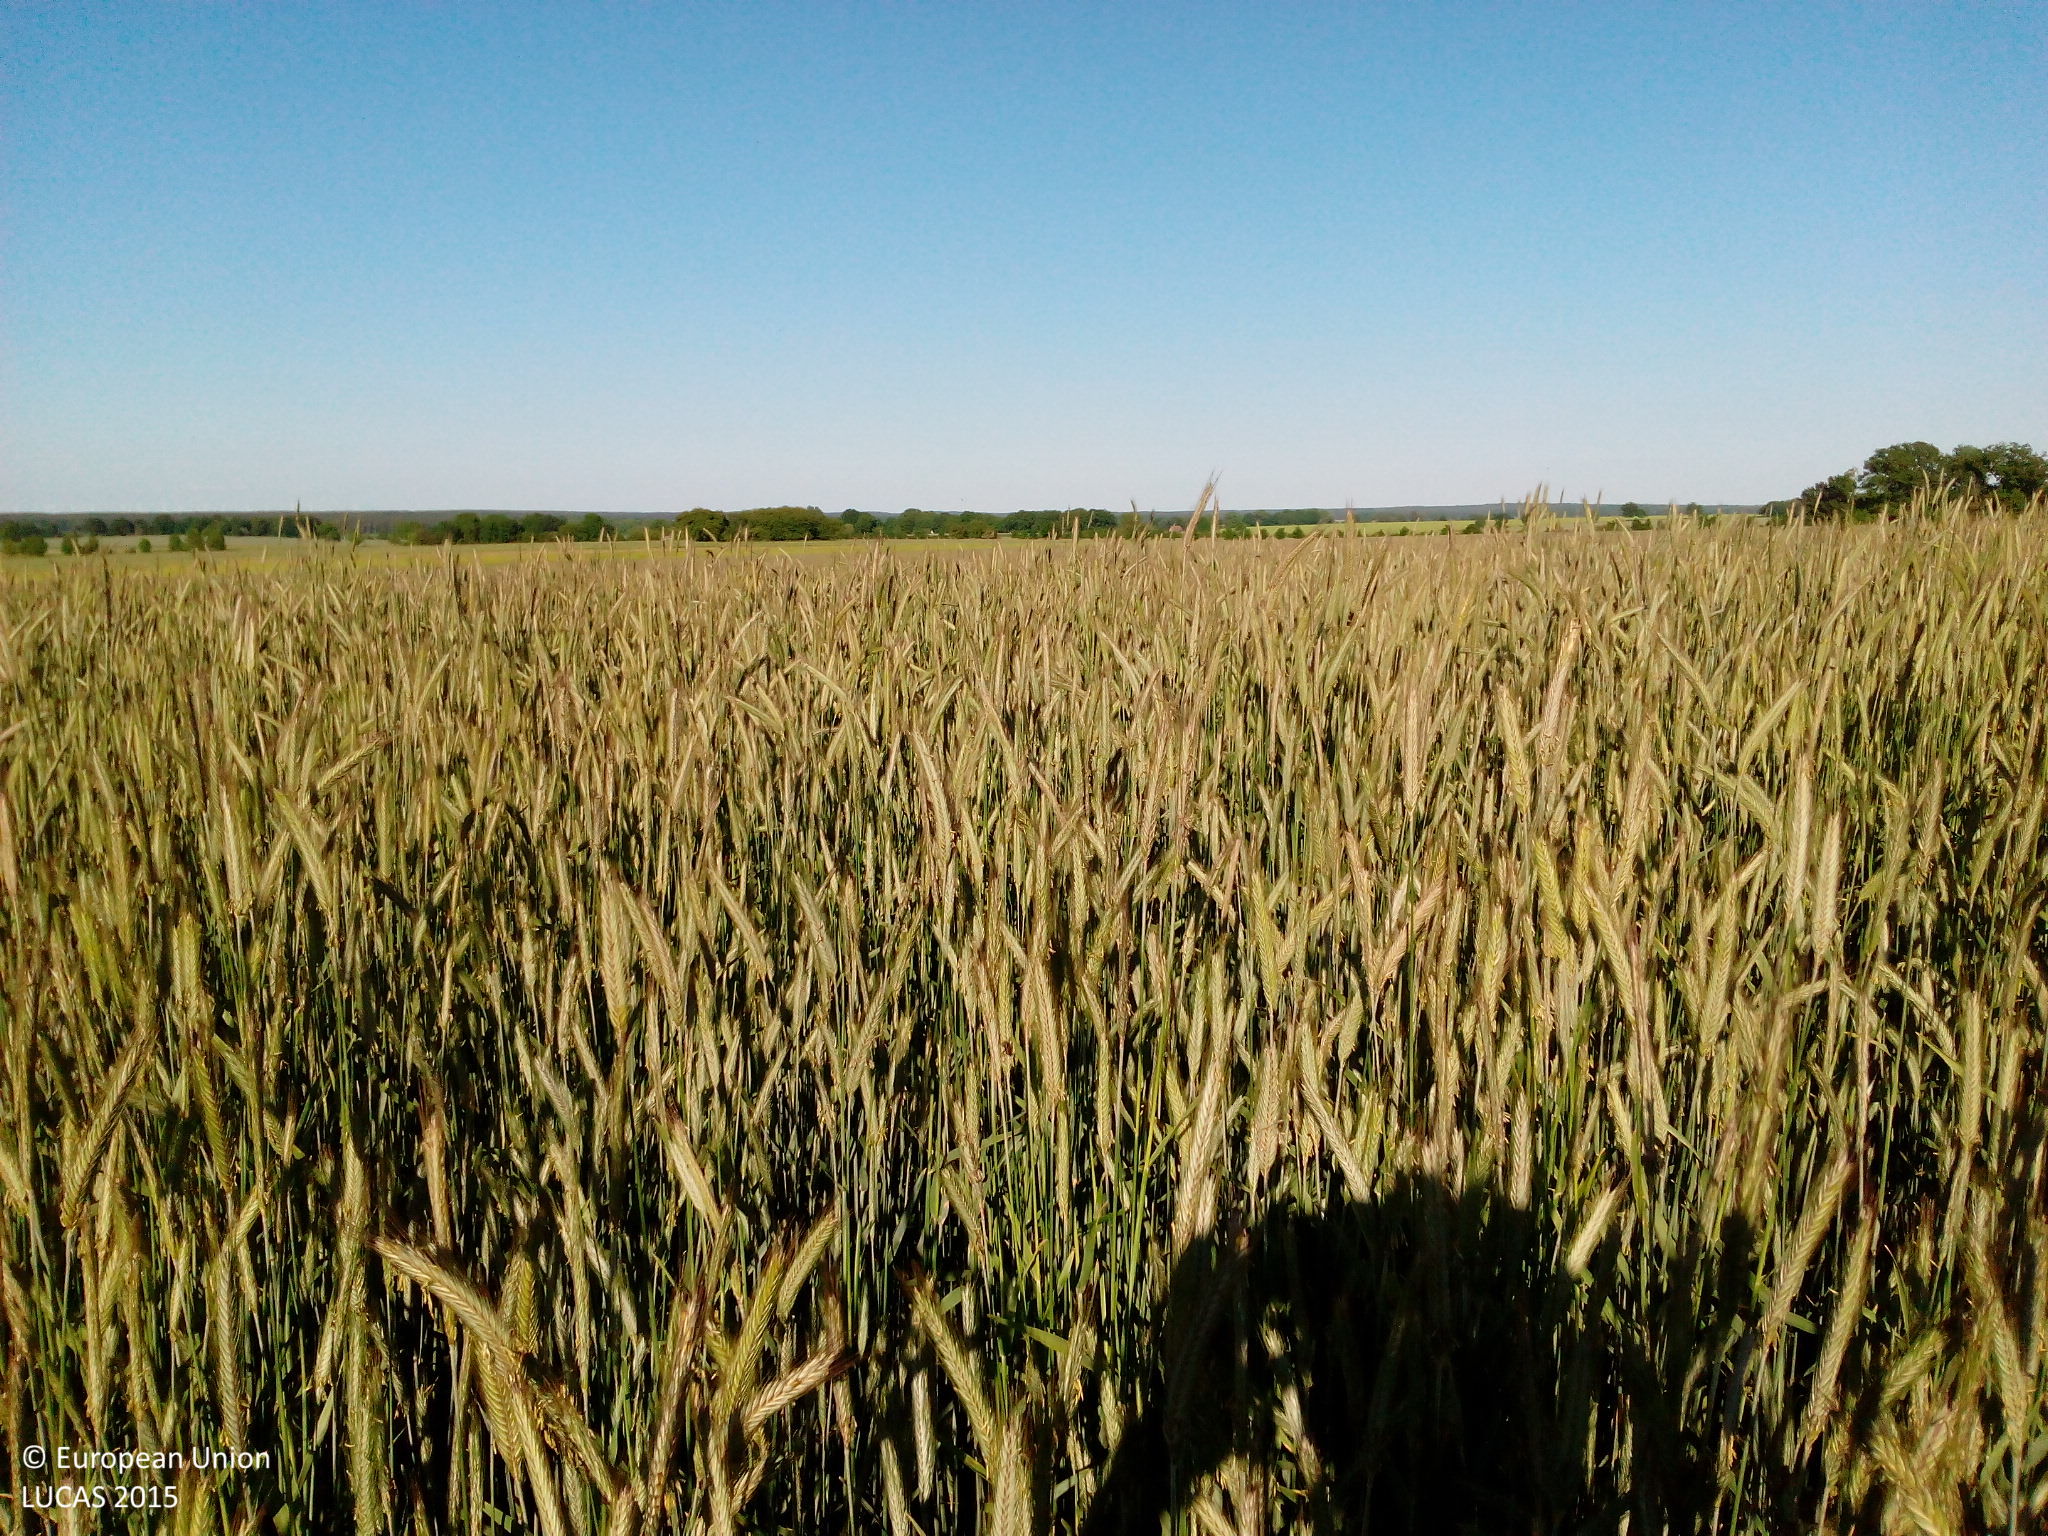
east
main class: Cropland
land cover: Rye
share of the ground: > 75 %
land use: Agriculture (excluding fallow land and kitchen gardens)
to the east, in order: Rye; Barley
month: June
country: DE
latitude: 53.2712
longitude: 12.3535
